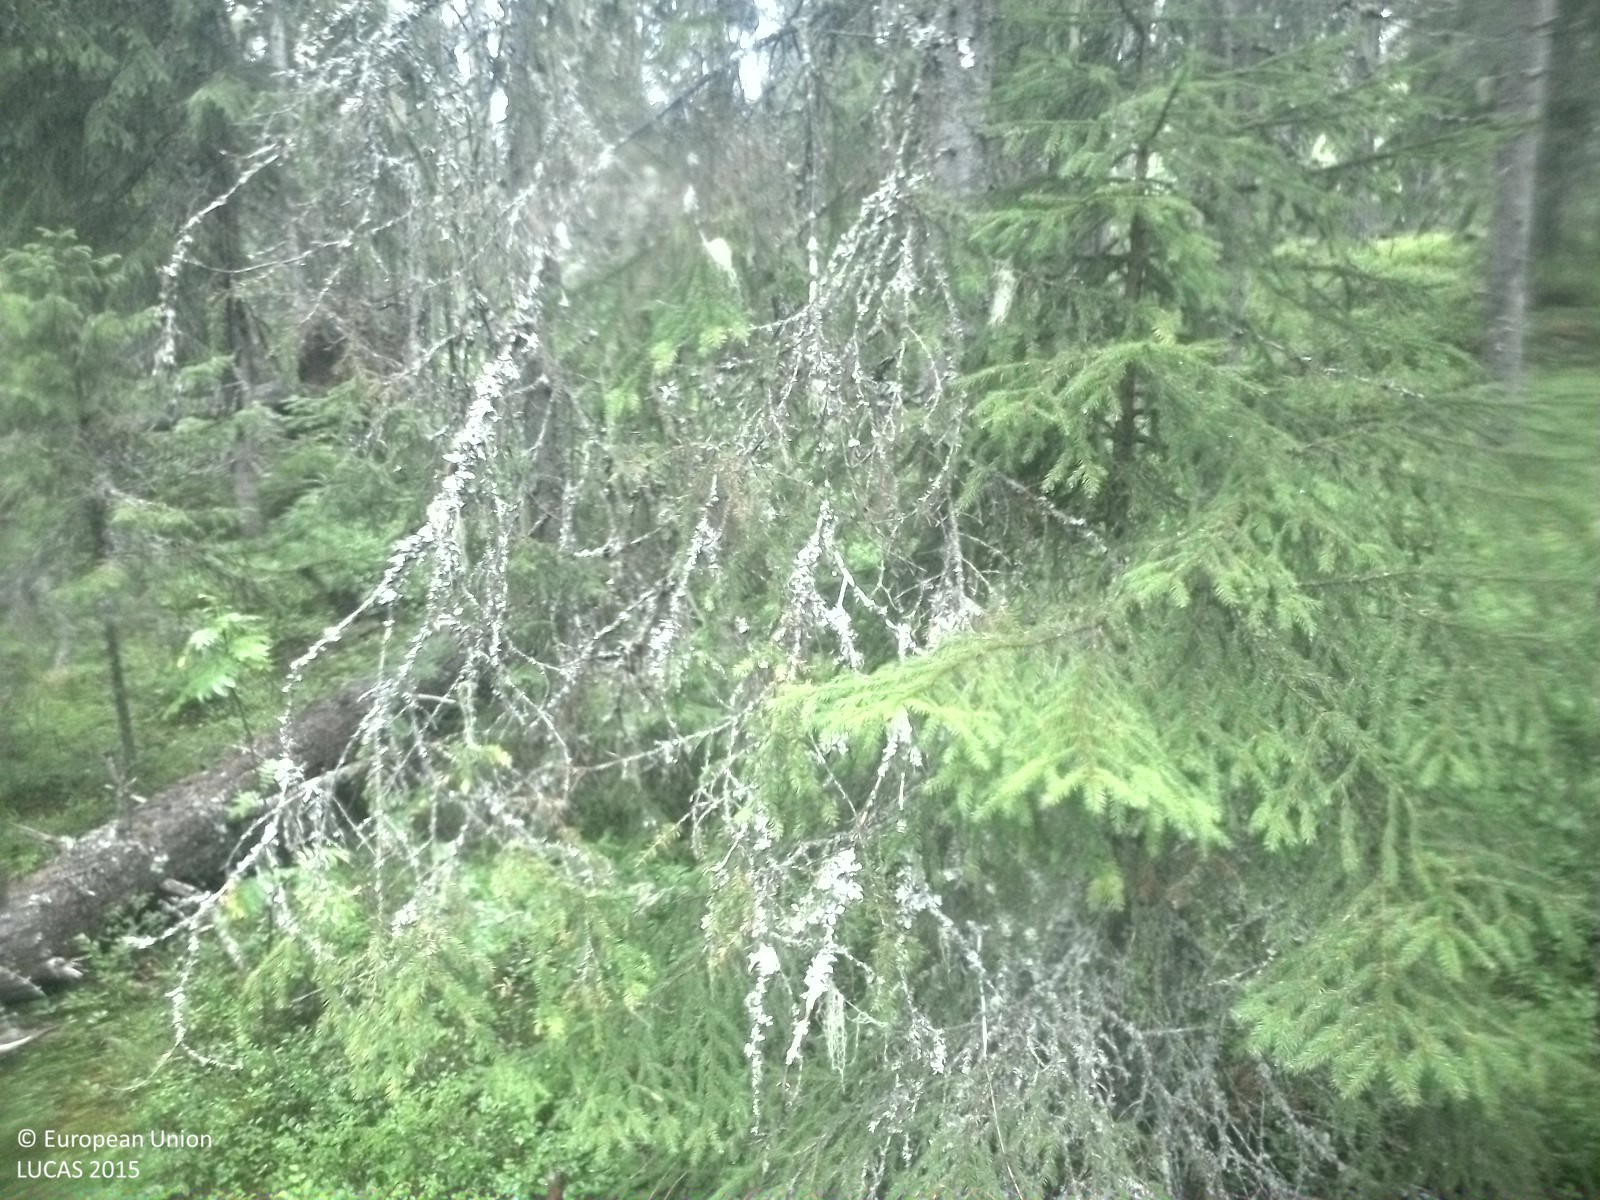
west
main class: Woodland
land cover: Spruce dominated coniferous woodland
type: boreal forest
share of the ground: 50 - 75 %
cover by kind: coniferous forest trees 55 %, shrubs 40 %, broadleaved forest trees 5 %
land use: Forestry
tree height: > 5 m
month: August
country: SE
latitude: 62.2643
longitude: 16.2786
